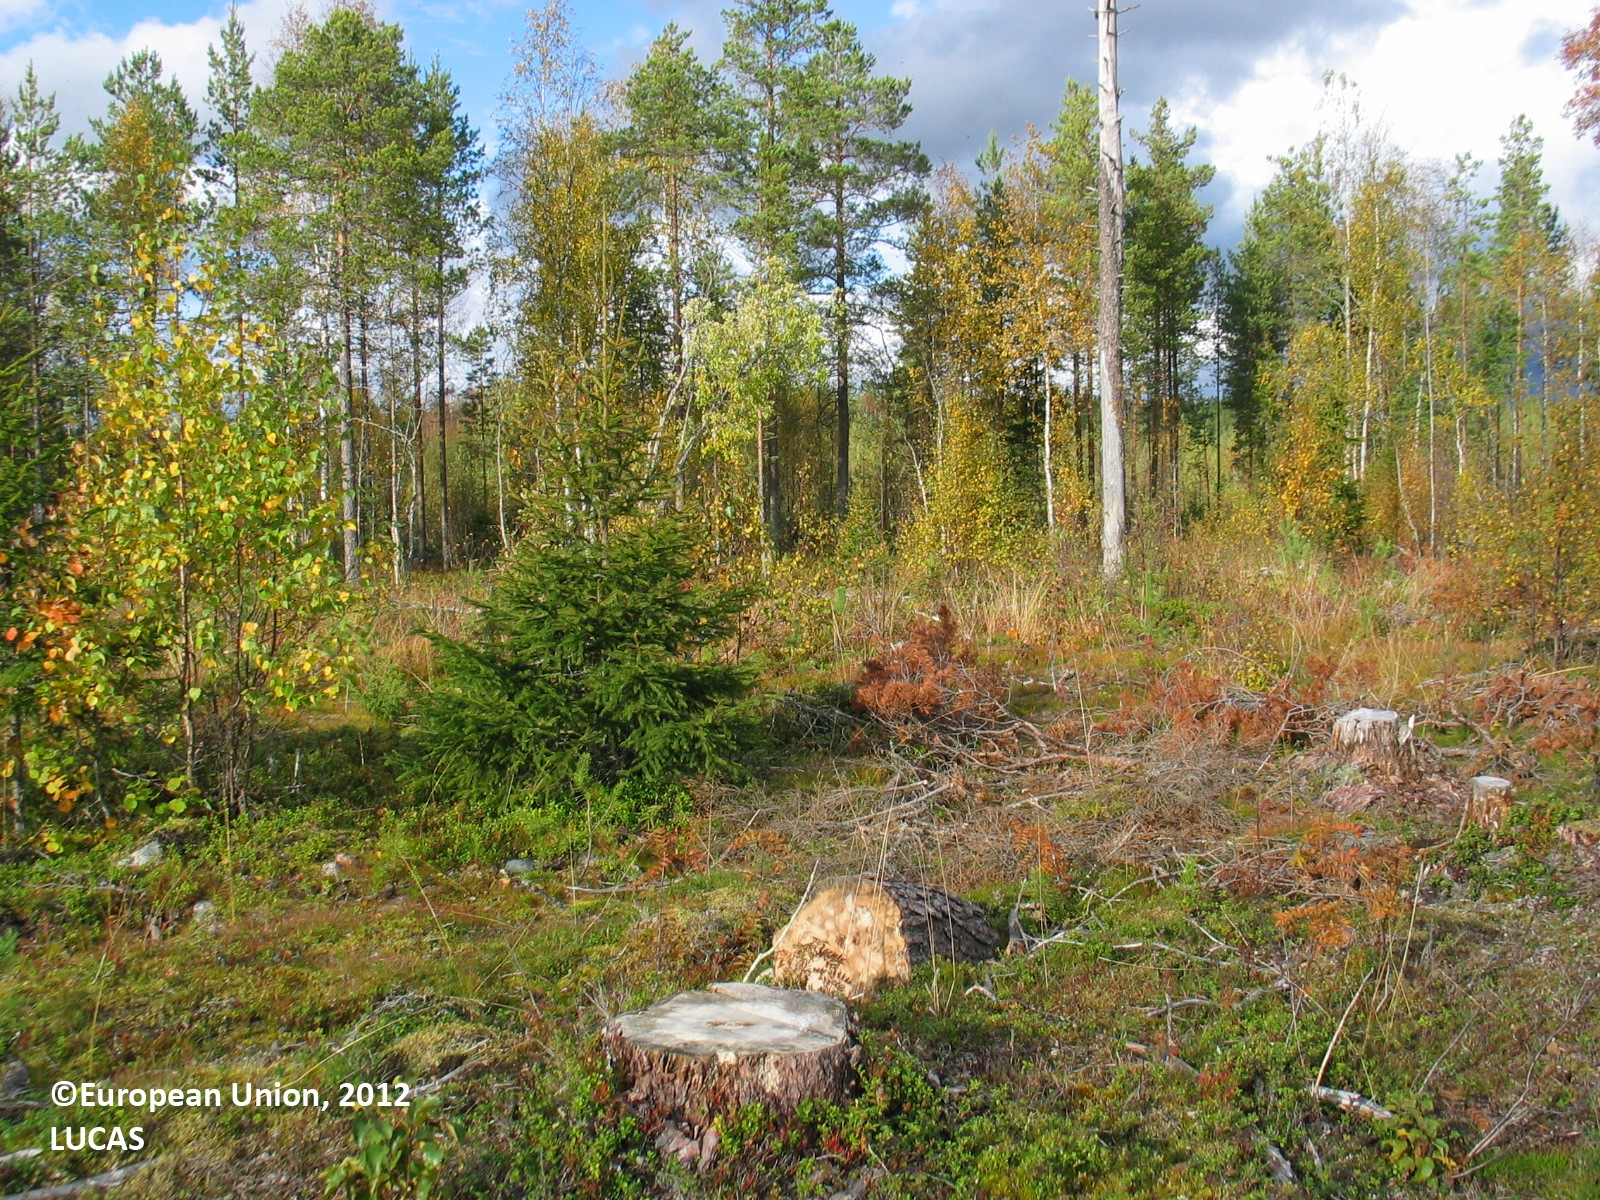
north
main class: Woodland
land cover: Other mixed woodland
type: boreal forest
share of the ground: 25 - 50 %
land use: Forestry
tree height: < 5 m
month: September
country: FI
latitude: 65.5617
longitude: 25.6110
